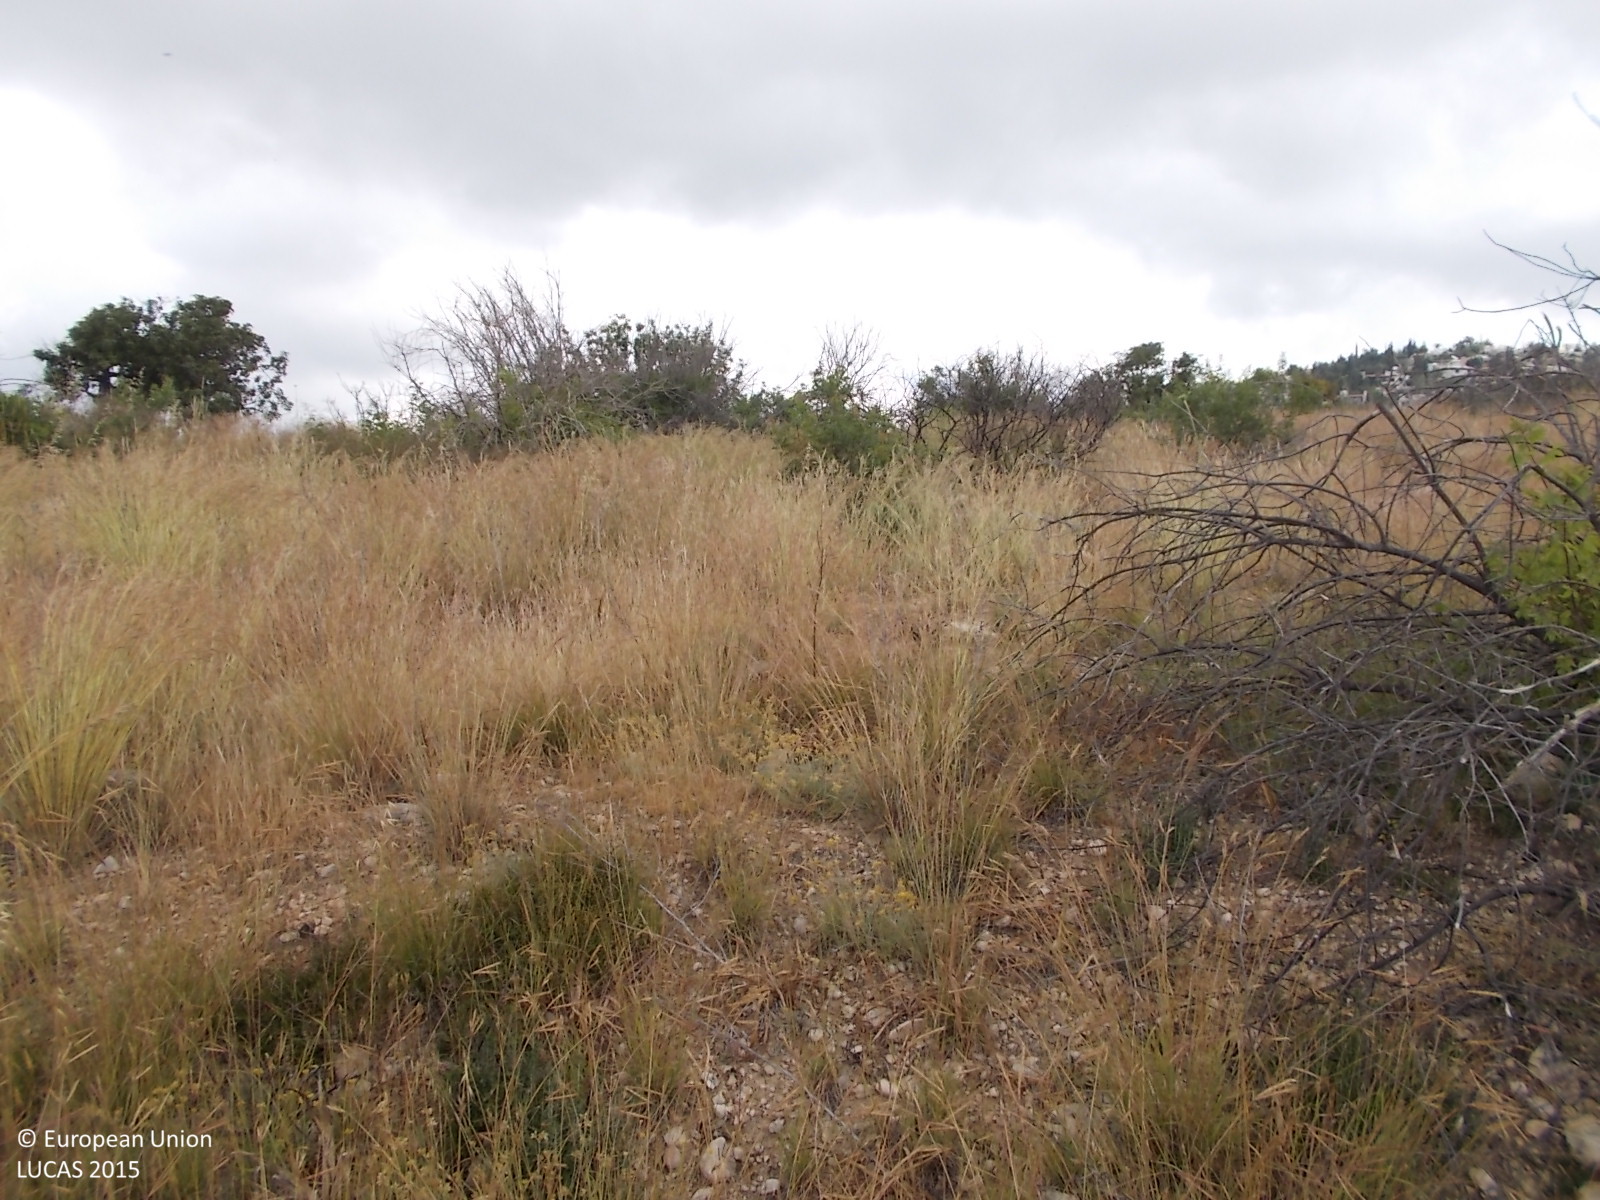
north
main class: Shrubland
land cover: Shrubland without tree cover
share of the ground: 25 - 50 %
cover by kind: herbaceous plants 45 %, unconsolidated bare surface 30 %, shrubs 25 %
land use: Semi-natural and natural areas not in use
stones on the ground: 25 - 50 %
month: May
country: CY
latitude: 34.8456
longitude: 32.4242
